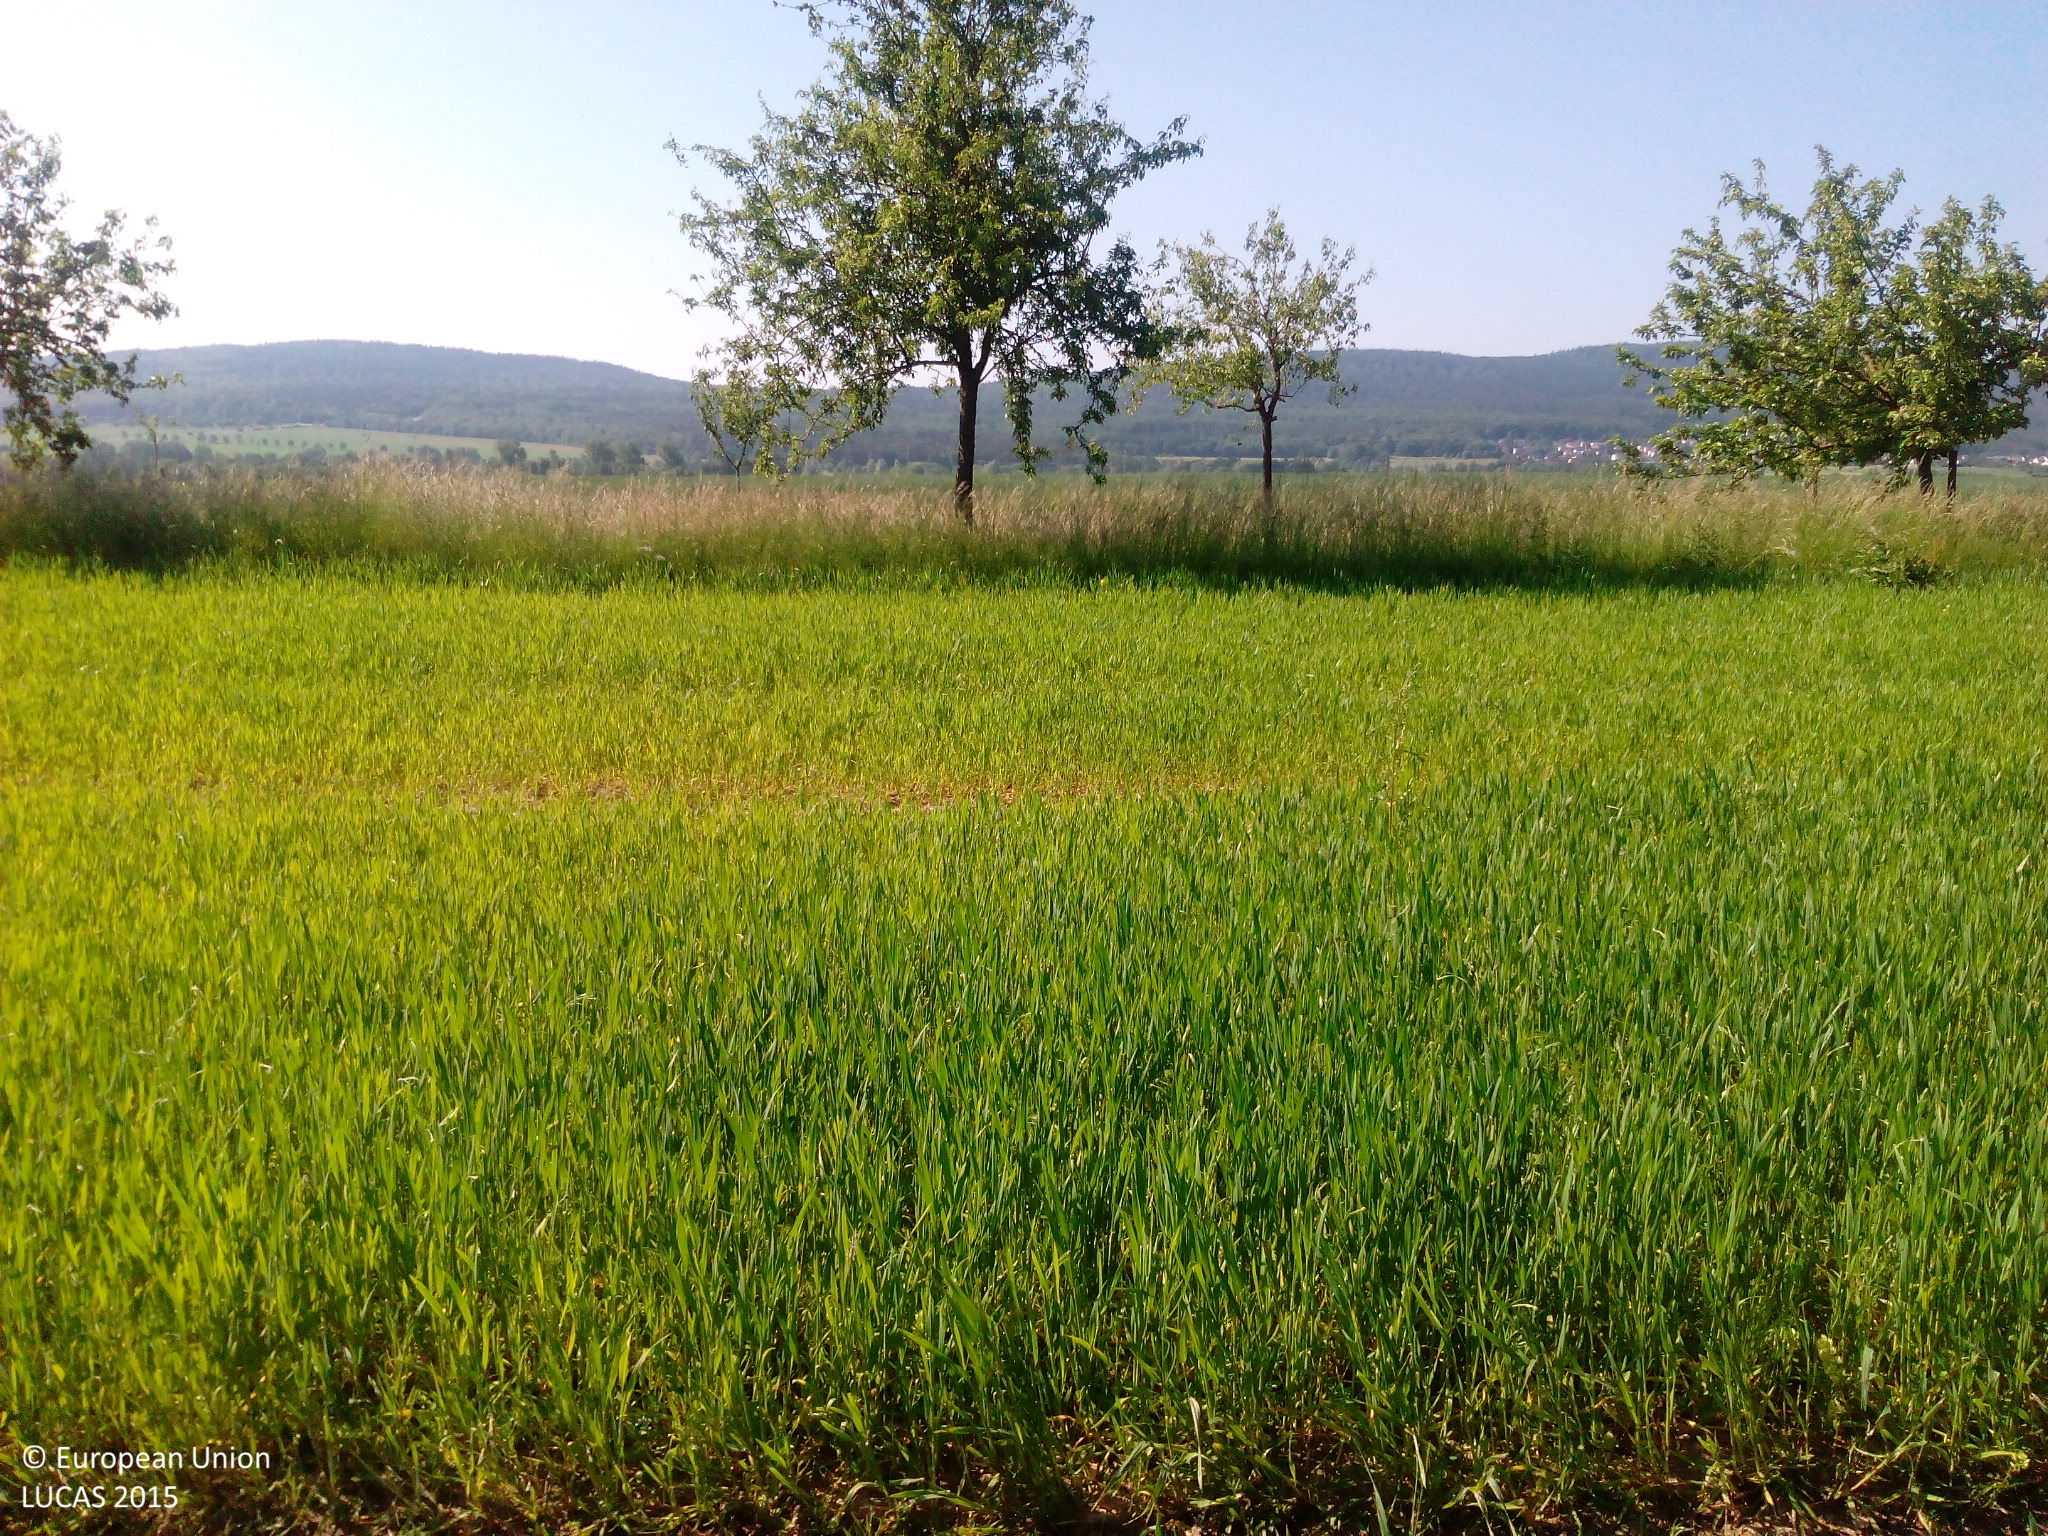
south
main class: Cropland
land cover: Common wheat
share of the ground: > 75 %
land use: Agriculture (excluding fallow land and kitchen gardens)
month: June
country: DE
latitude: 50.3010
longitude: 8.5543
